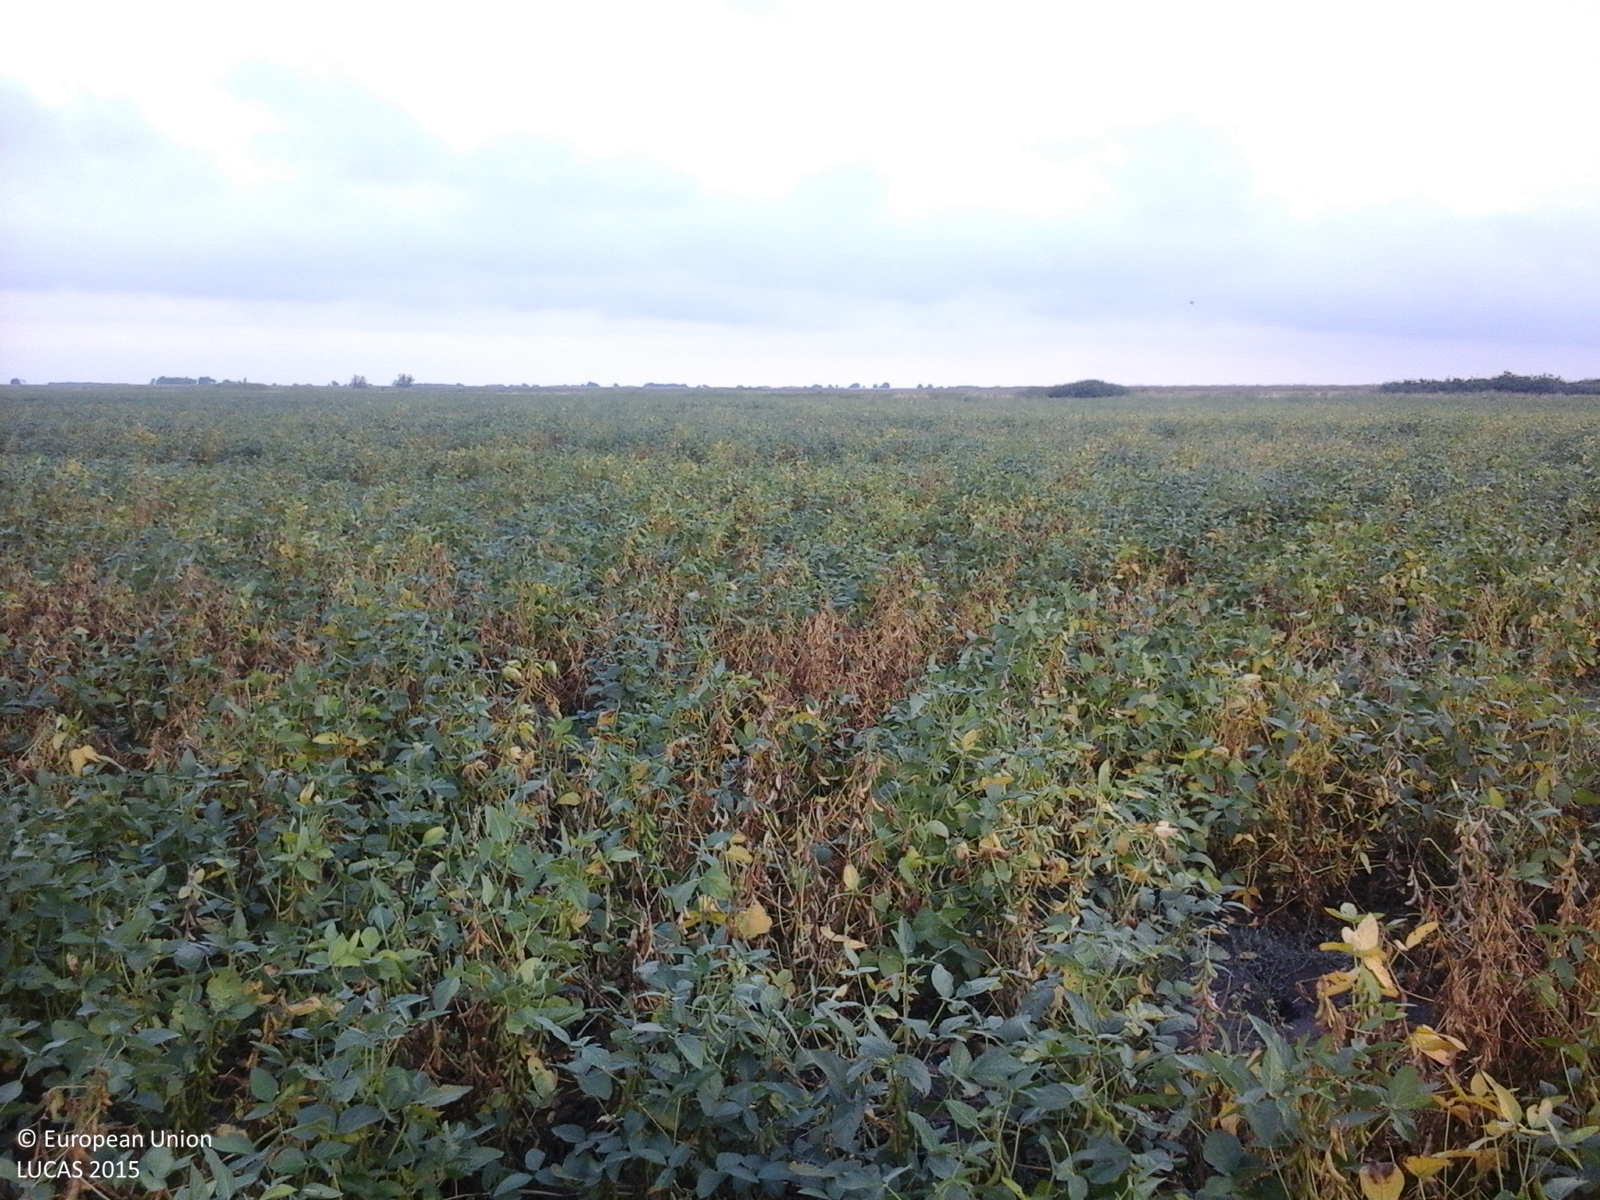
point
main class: Cropland
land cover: Soya
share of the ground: > 75 %
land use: Agriculture (excluding fallow land and kitchen gardens)
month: August
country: RO
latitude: 45.9637
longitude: 20.4629
